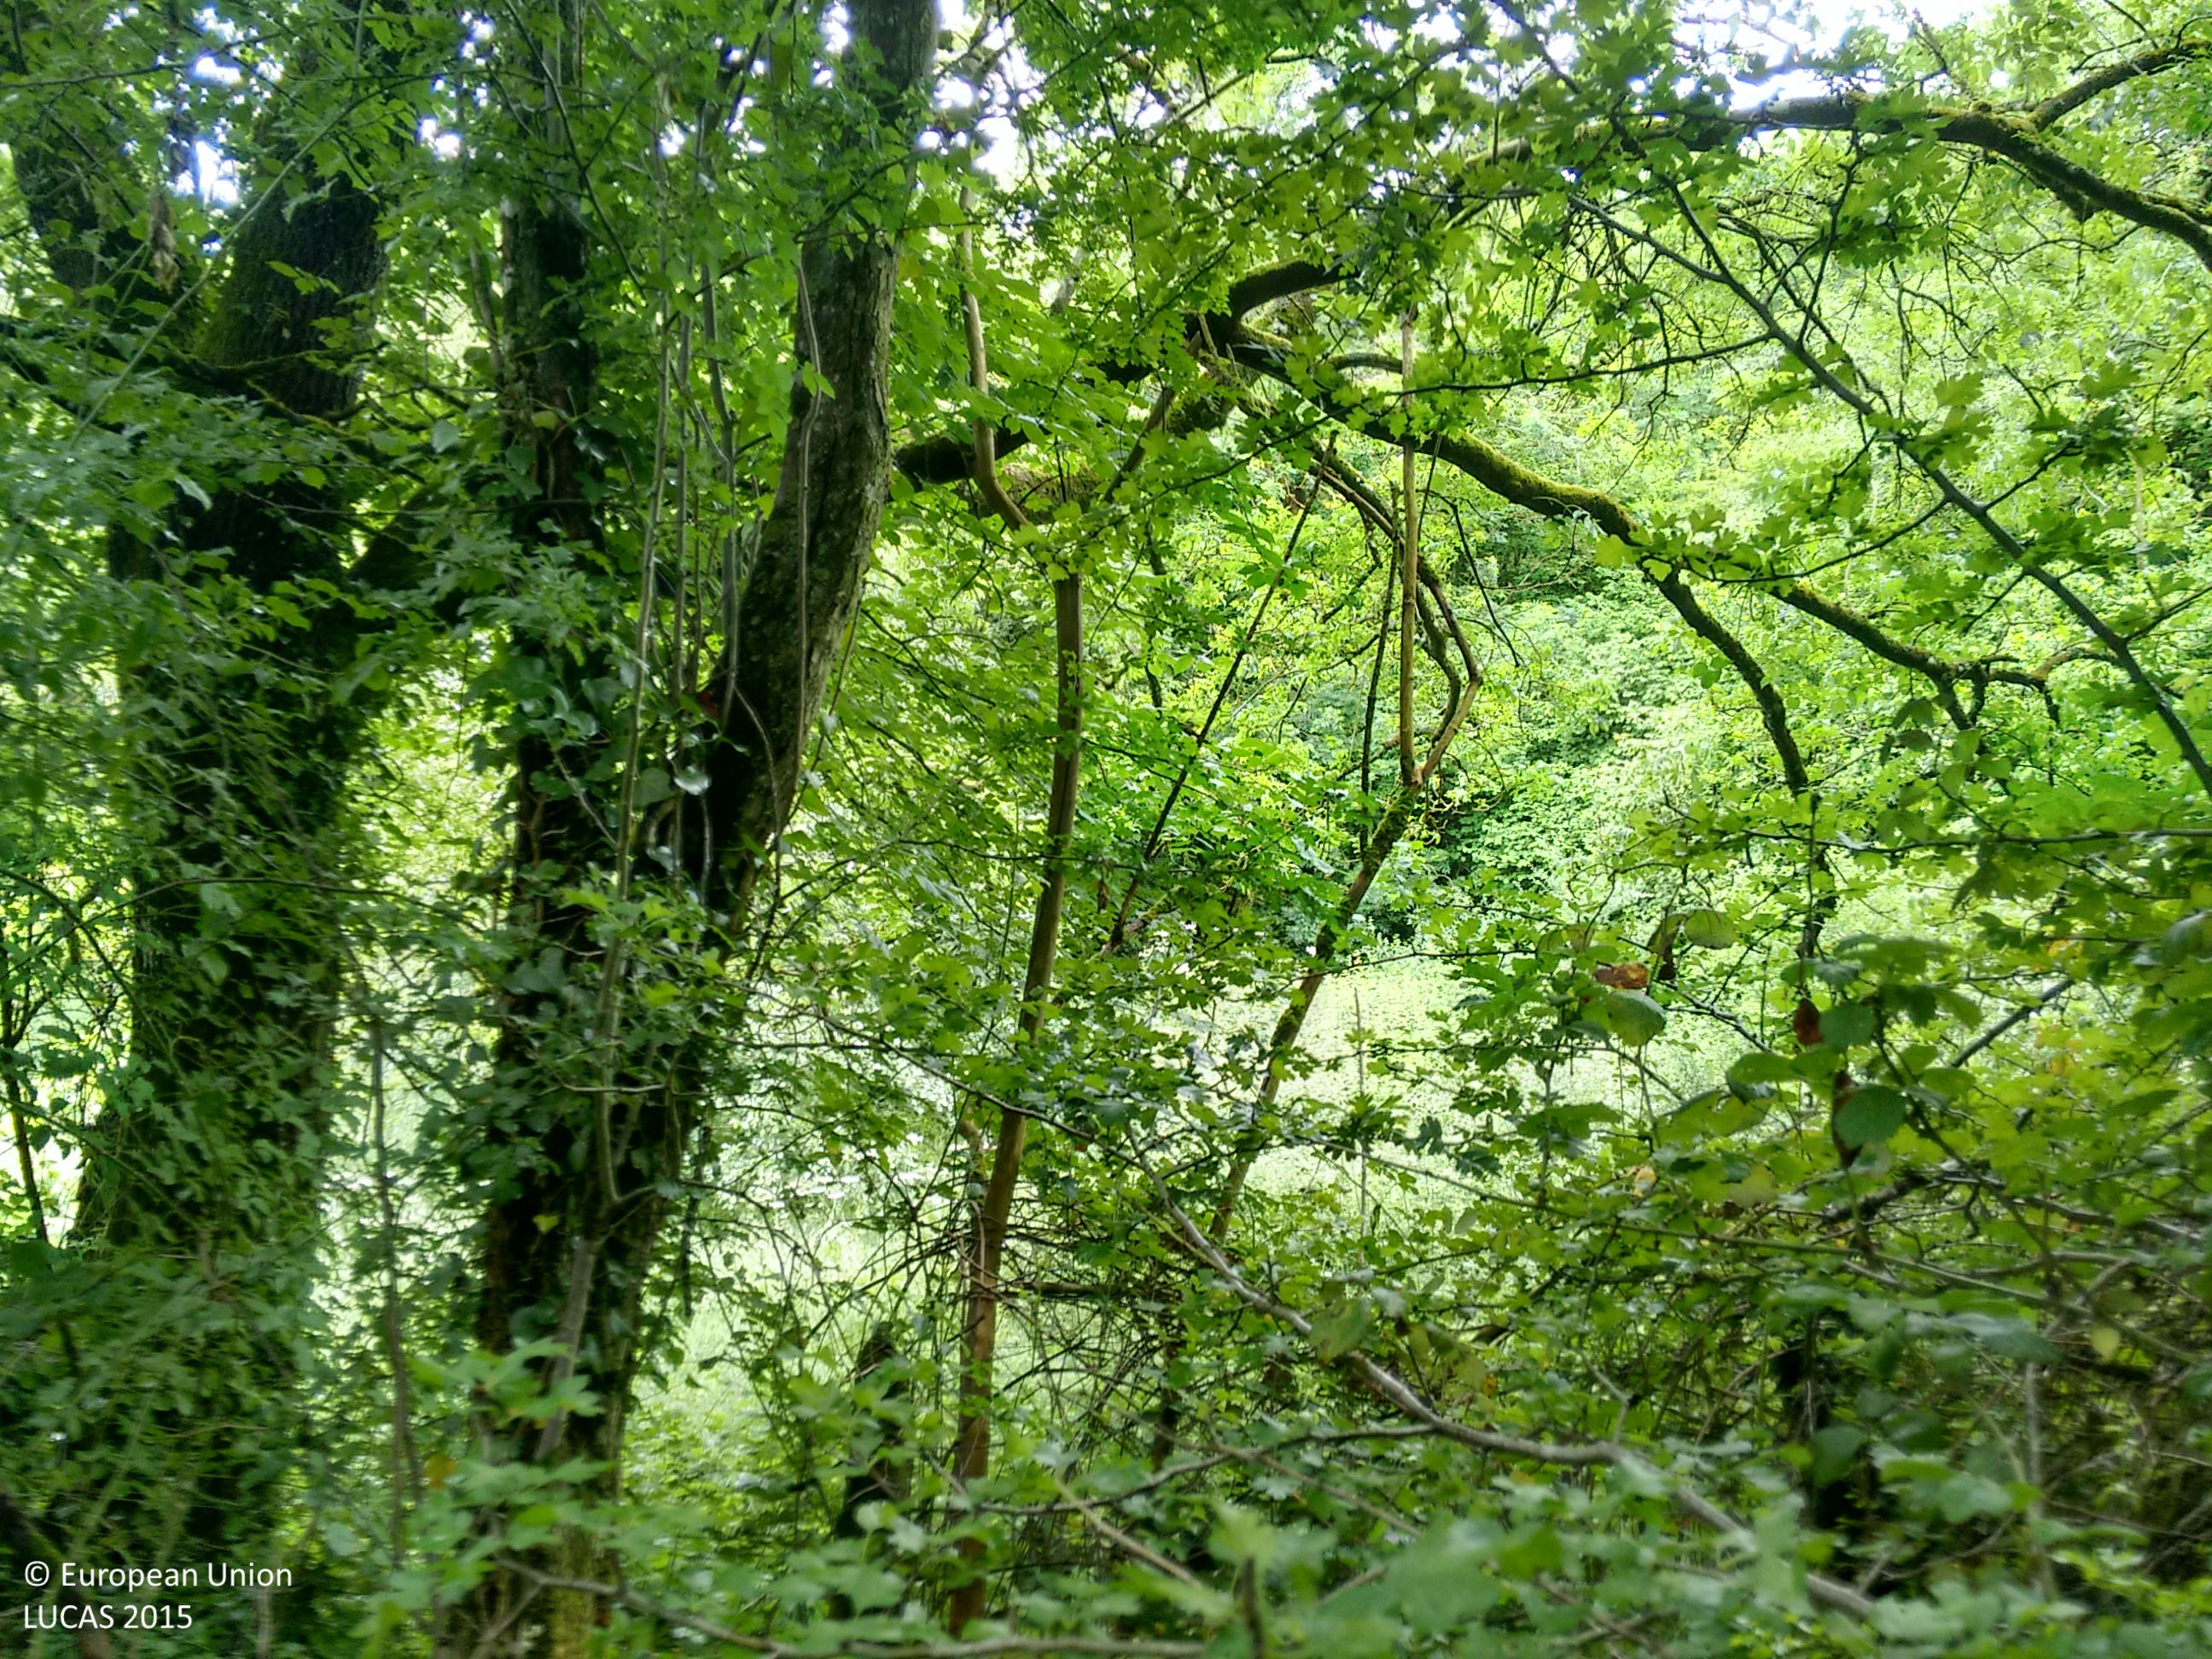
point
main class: Woodland
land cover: Broadleaved woodland
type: mesophytic deciduous forest
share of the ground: > 75 %
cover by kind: broadleaved forest trees 100 %
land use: Semi-natural and natural areas not in use
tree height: > 5 m
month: June
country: GB
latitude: 51.2833
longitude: -2.4386
